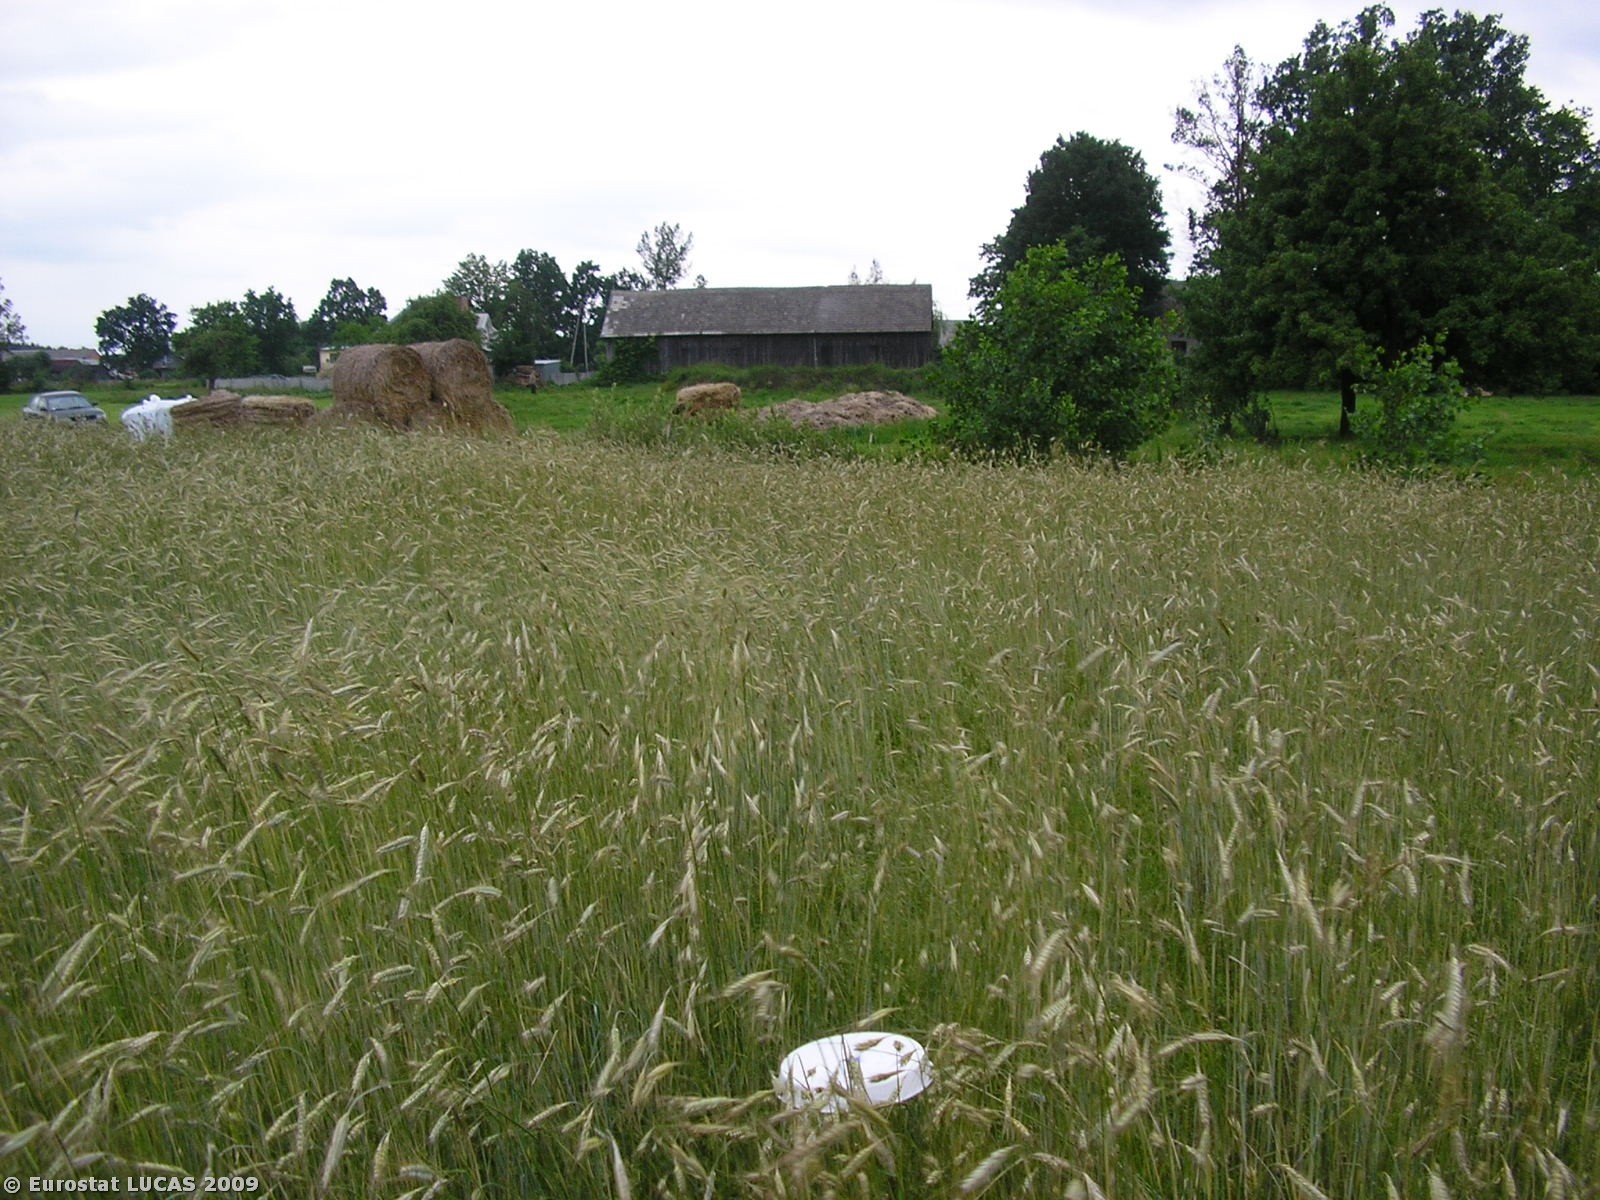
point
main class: Cropland
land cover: Rye
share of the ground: > 75 %
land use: Agriculture (excluding fallow land and kitchen gardens)
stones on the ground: < 10 %
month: June
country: PL
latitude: 51.4661
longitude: 18.3819
